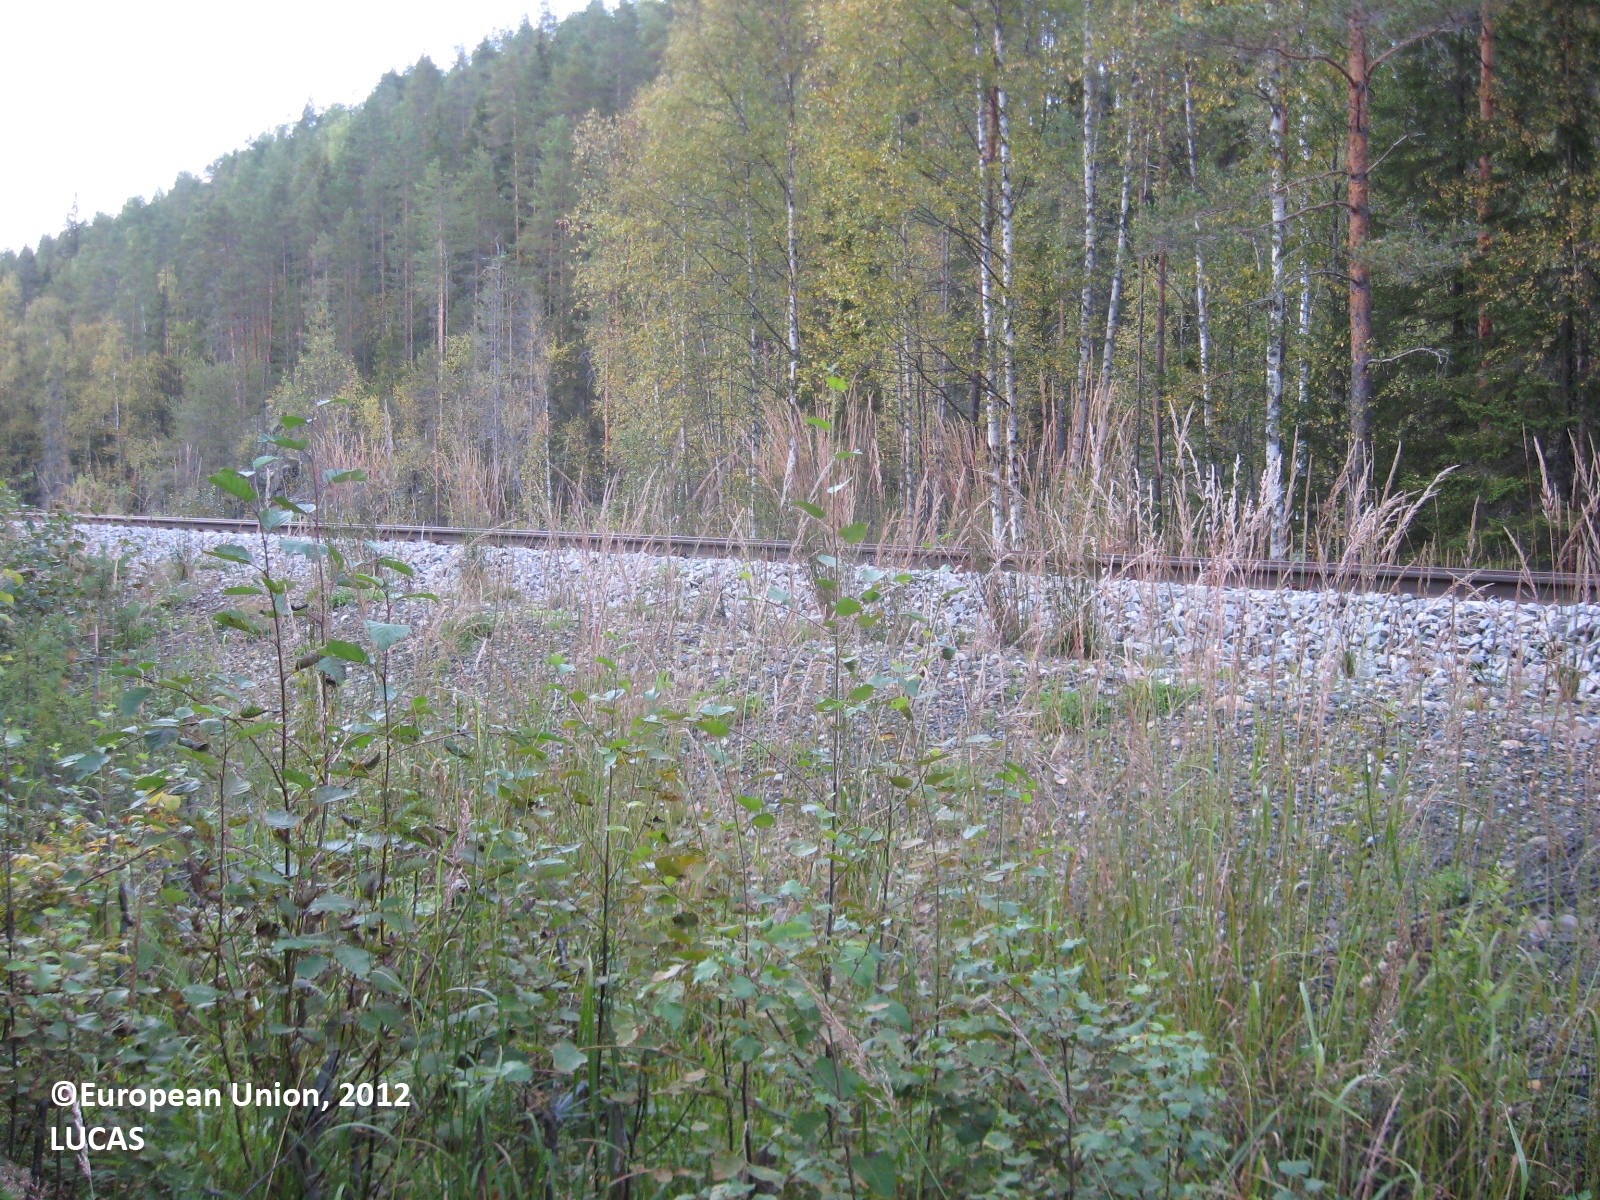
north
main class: Woodland
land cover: Other mixed woodland
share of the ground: > 75 %
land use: Forestry
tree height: < 5 m
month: August
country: FI
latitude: 63.9363
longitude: 28.4390
